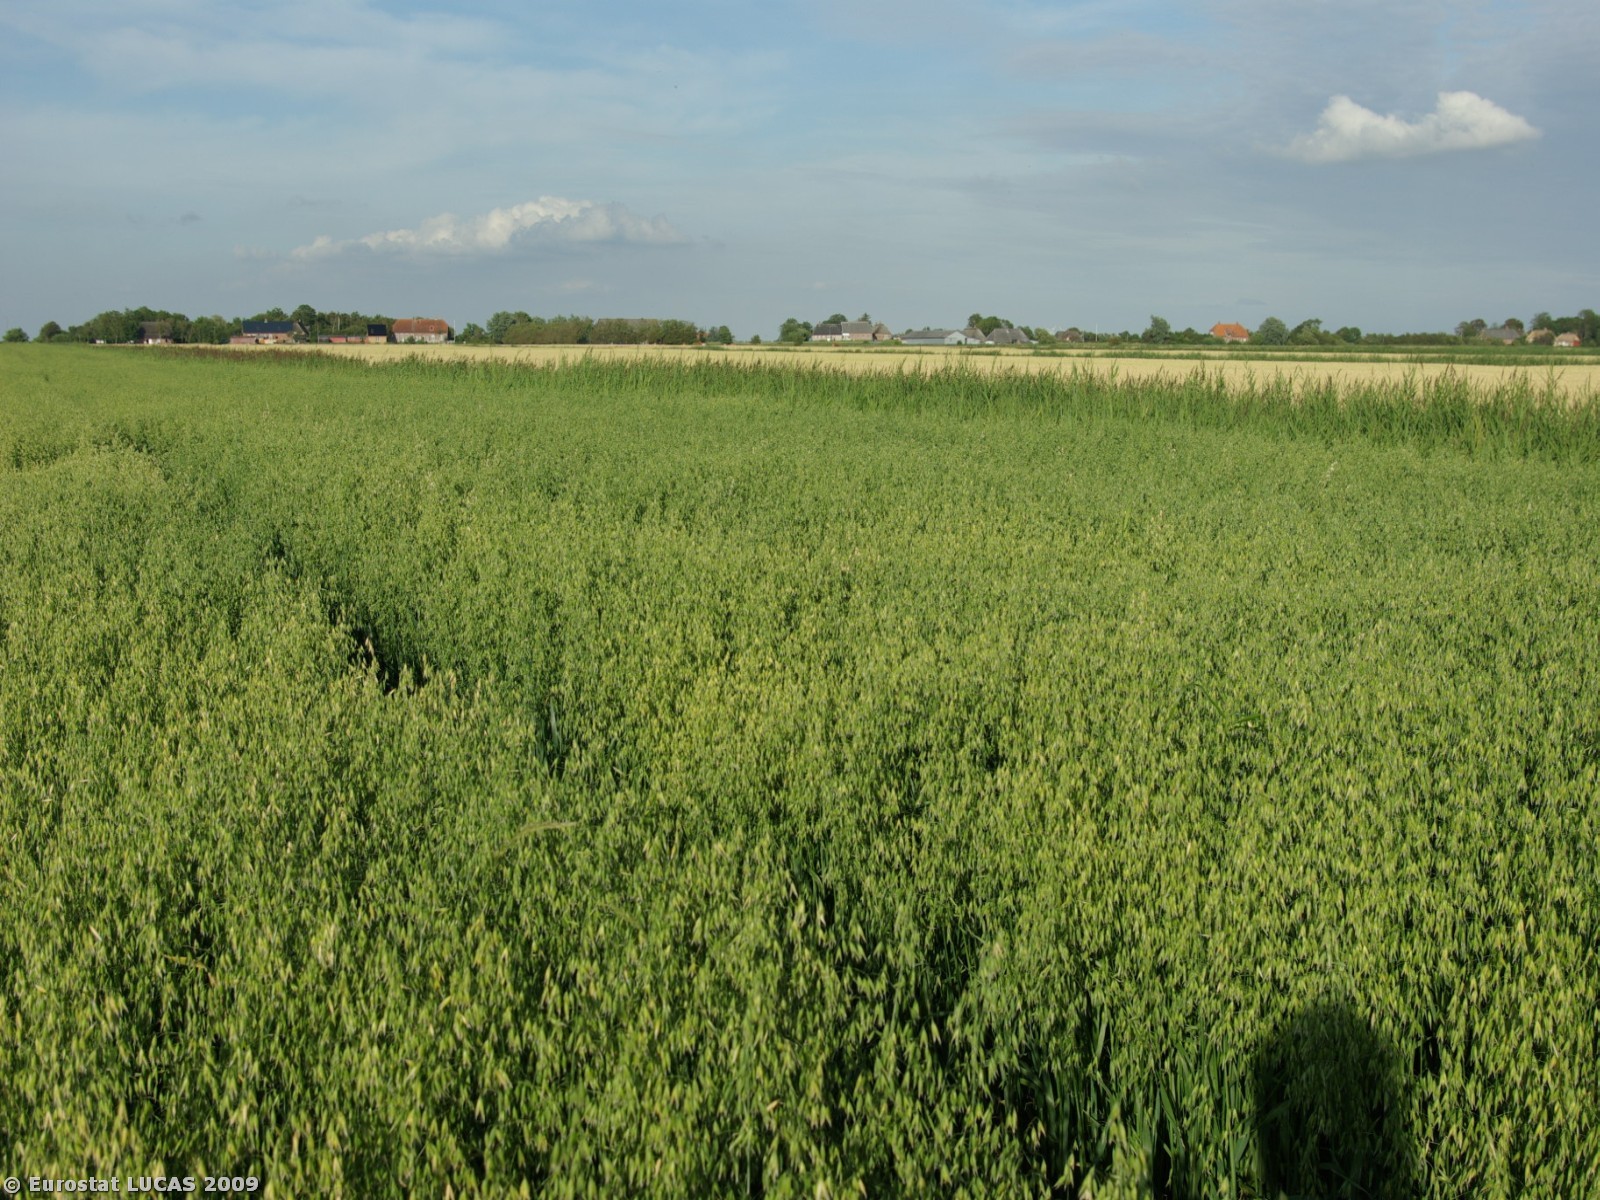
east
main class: Cropland
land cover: Oats
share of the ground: > 75 %
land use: Agriculture (excluding fallow land and kitchen gardens)
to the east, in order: Oats; Grass margins; Ditches and canals; Grass margins; Common wheat; Grass margins; Ditches and canals; Grass margins; Common wheat
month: July
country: DK
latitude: 54.9052
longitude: 8.7376
